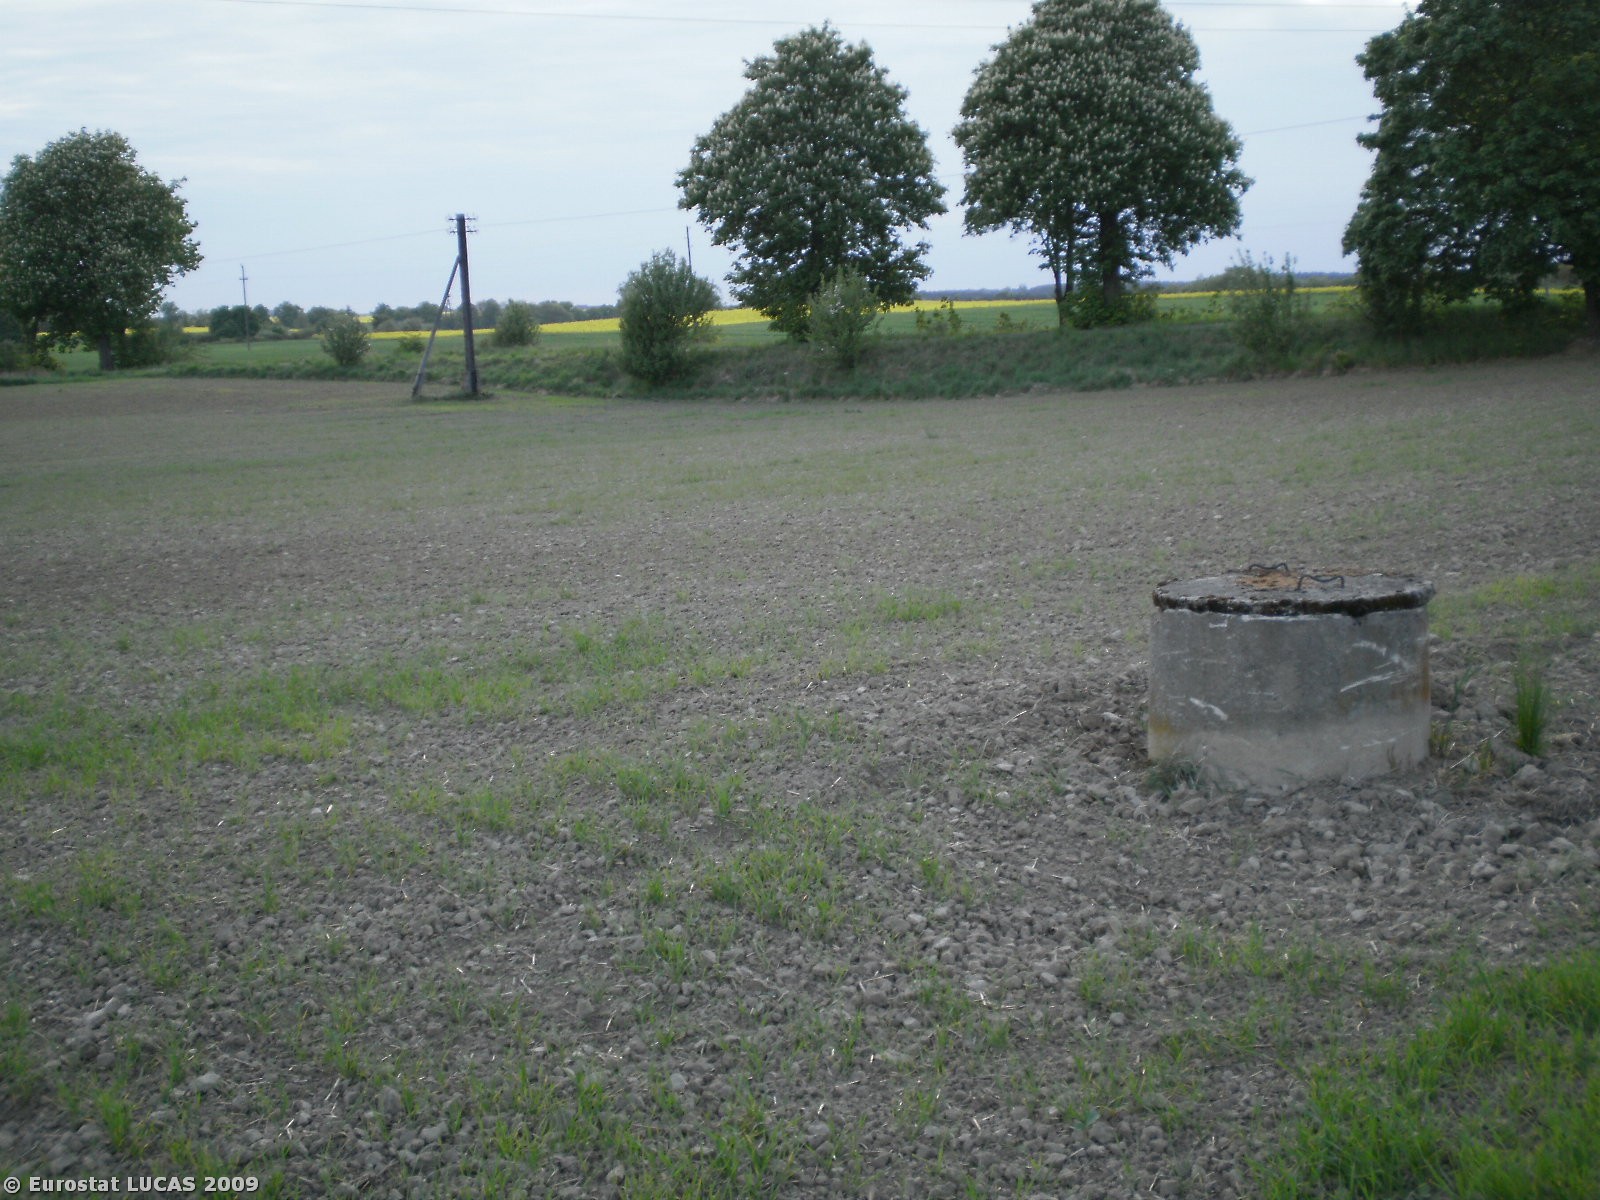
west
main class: Cropland
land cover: Common wheat
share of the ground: > 75 %
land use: Agriculture (excluding fallow land and kitchen gardens)
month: May
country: PL
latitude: 53.3696
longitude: 18.8130
